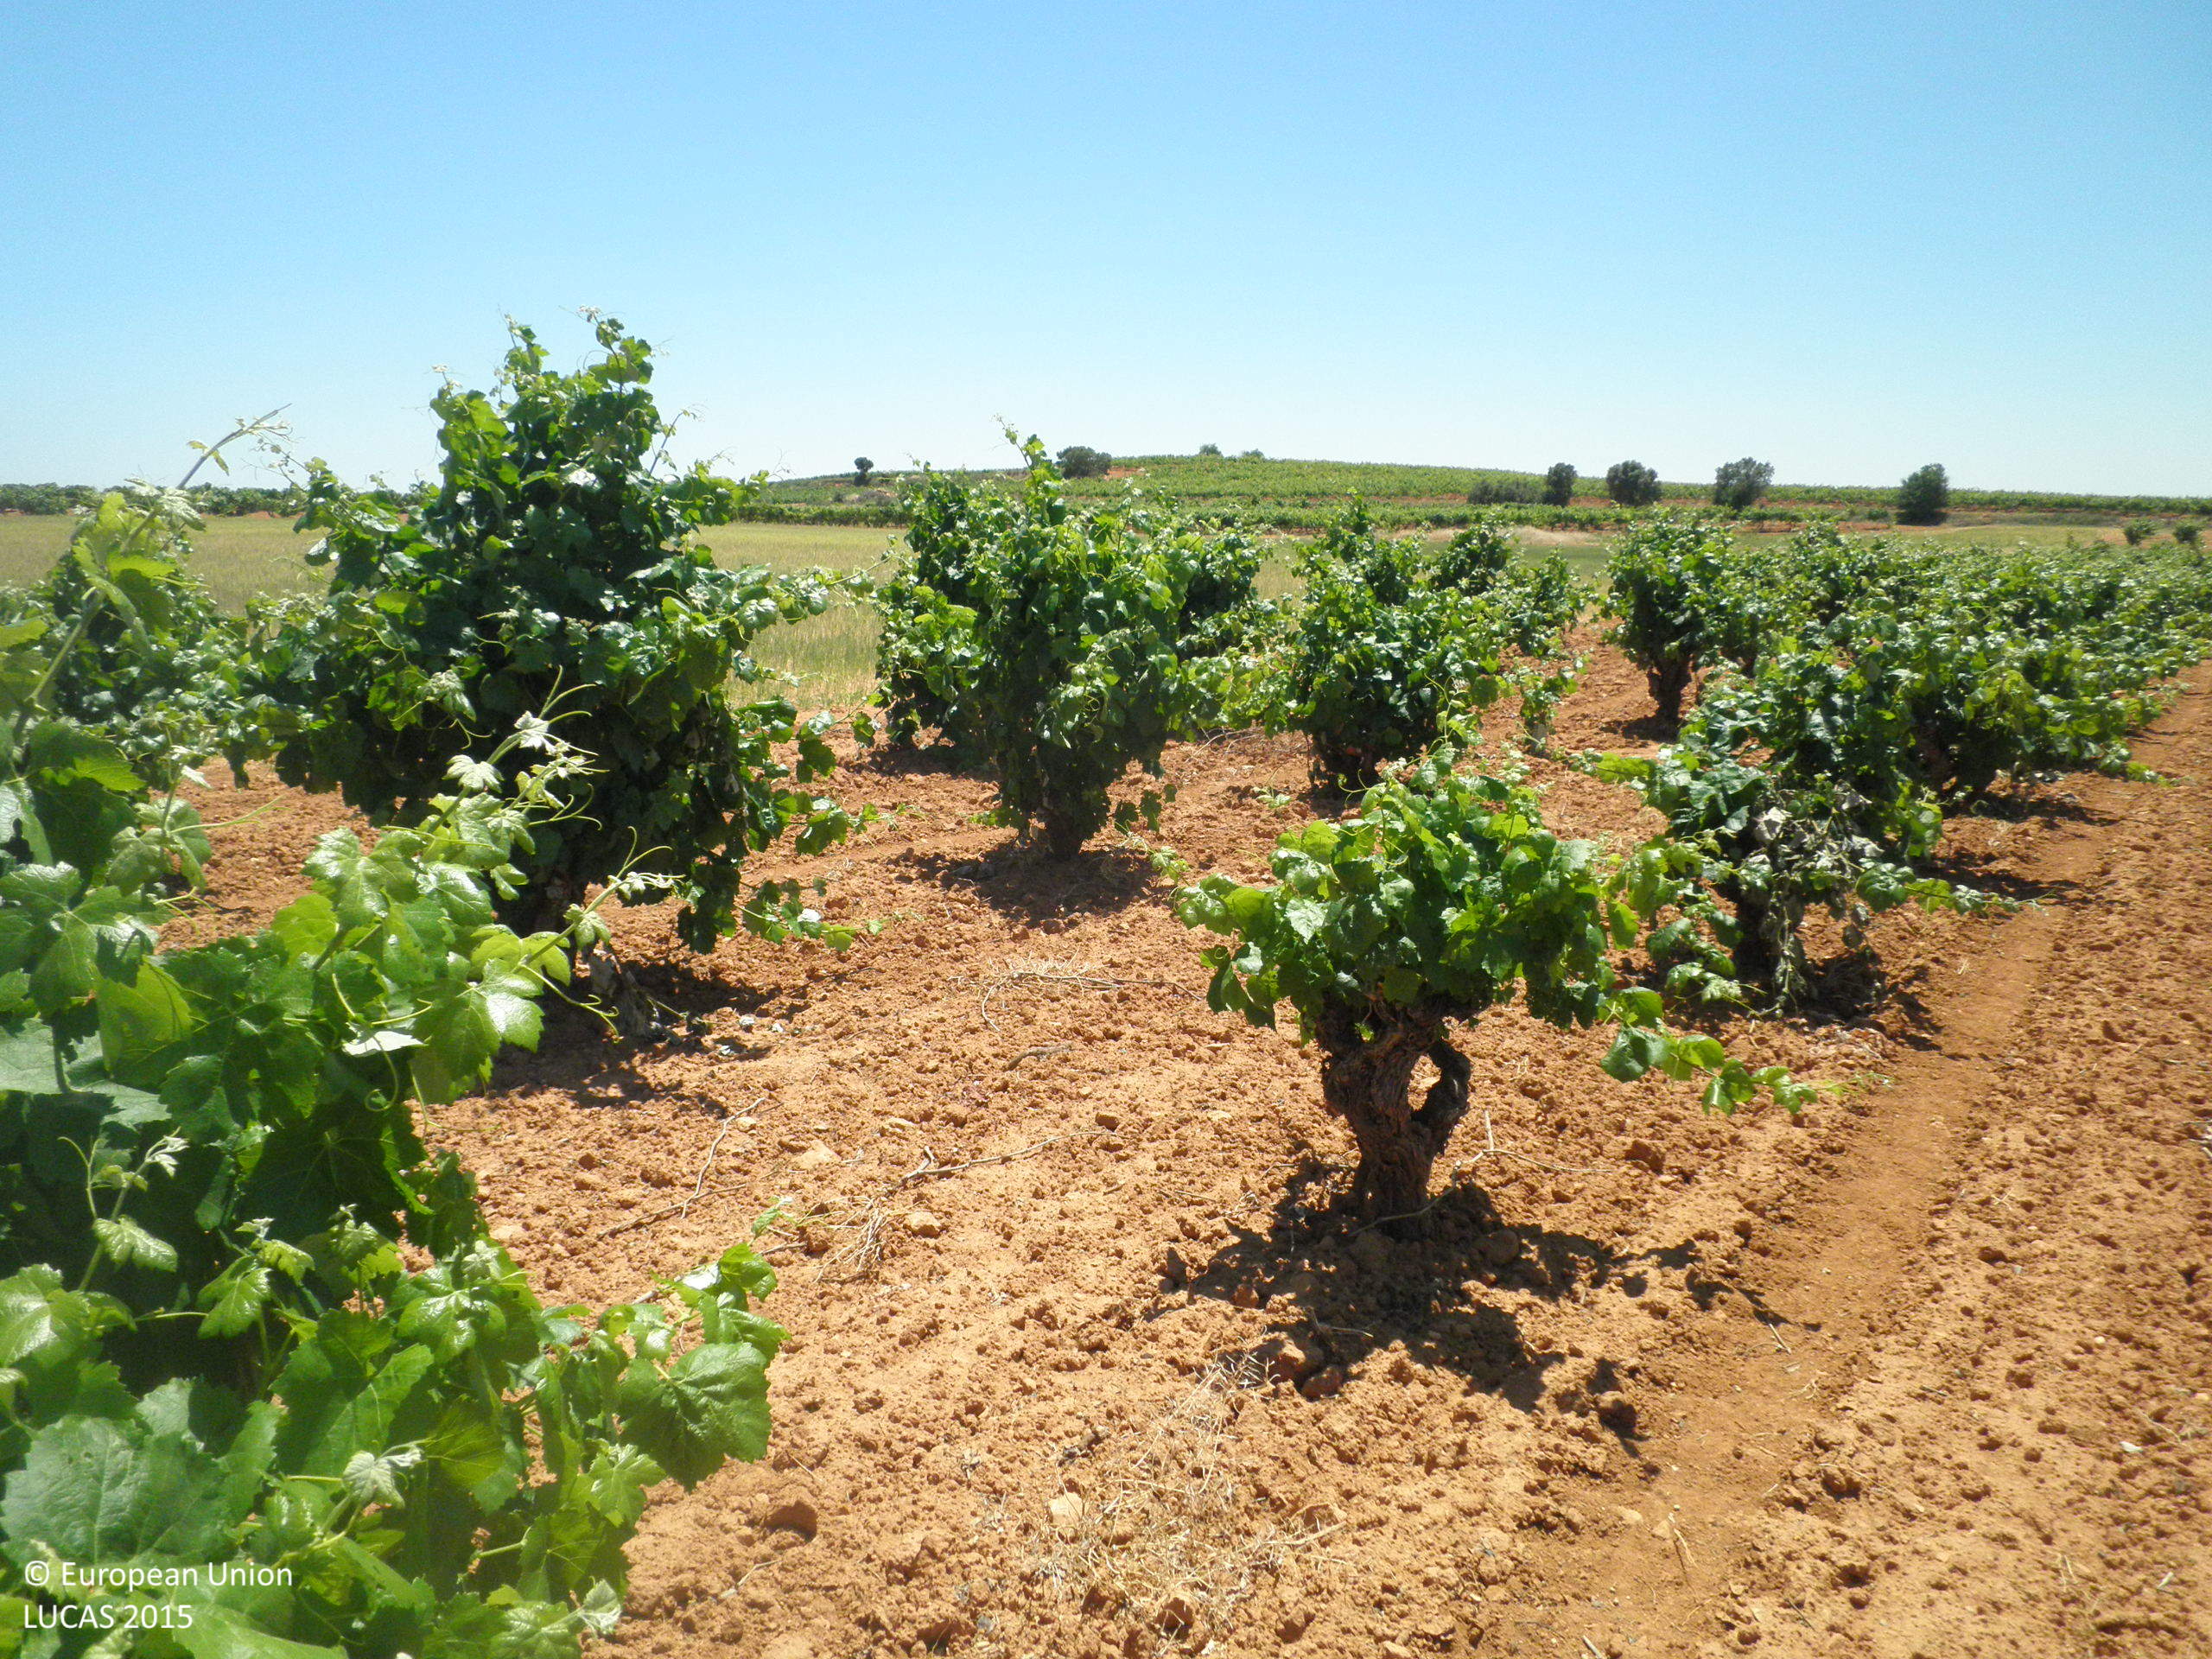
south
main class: Cropland
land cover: Vineyards
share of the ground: 10 - 25 %
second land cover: Other bare soil
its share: > 75 %
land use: Agriculture (excluding fallow land and kitchen gardens)
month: June
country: ES
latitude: 39.4749
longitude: -1.6879
